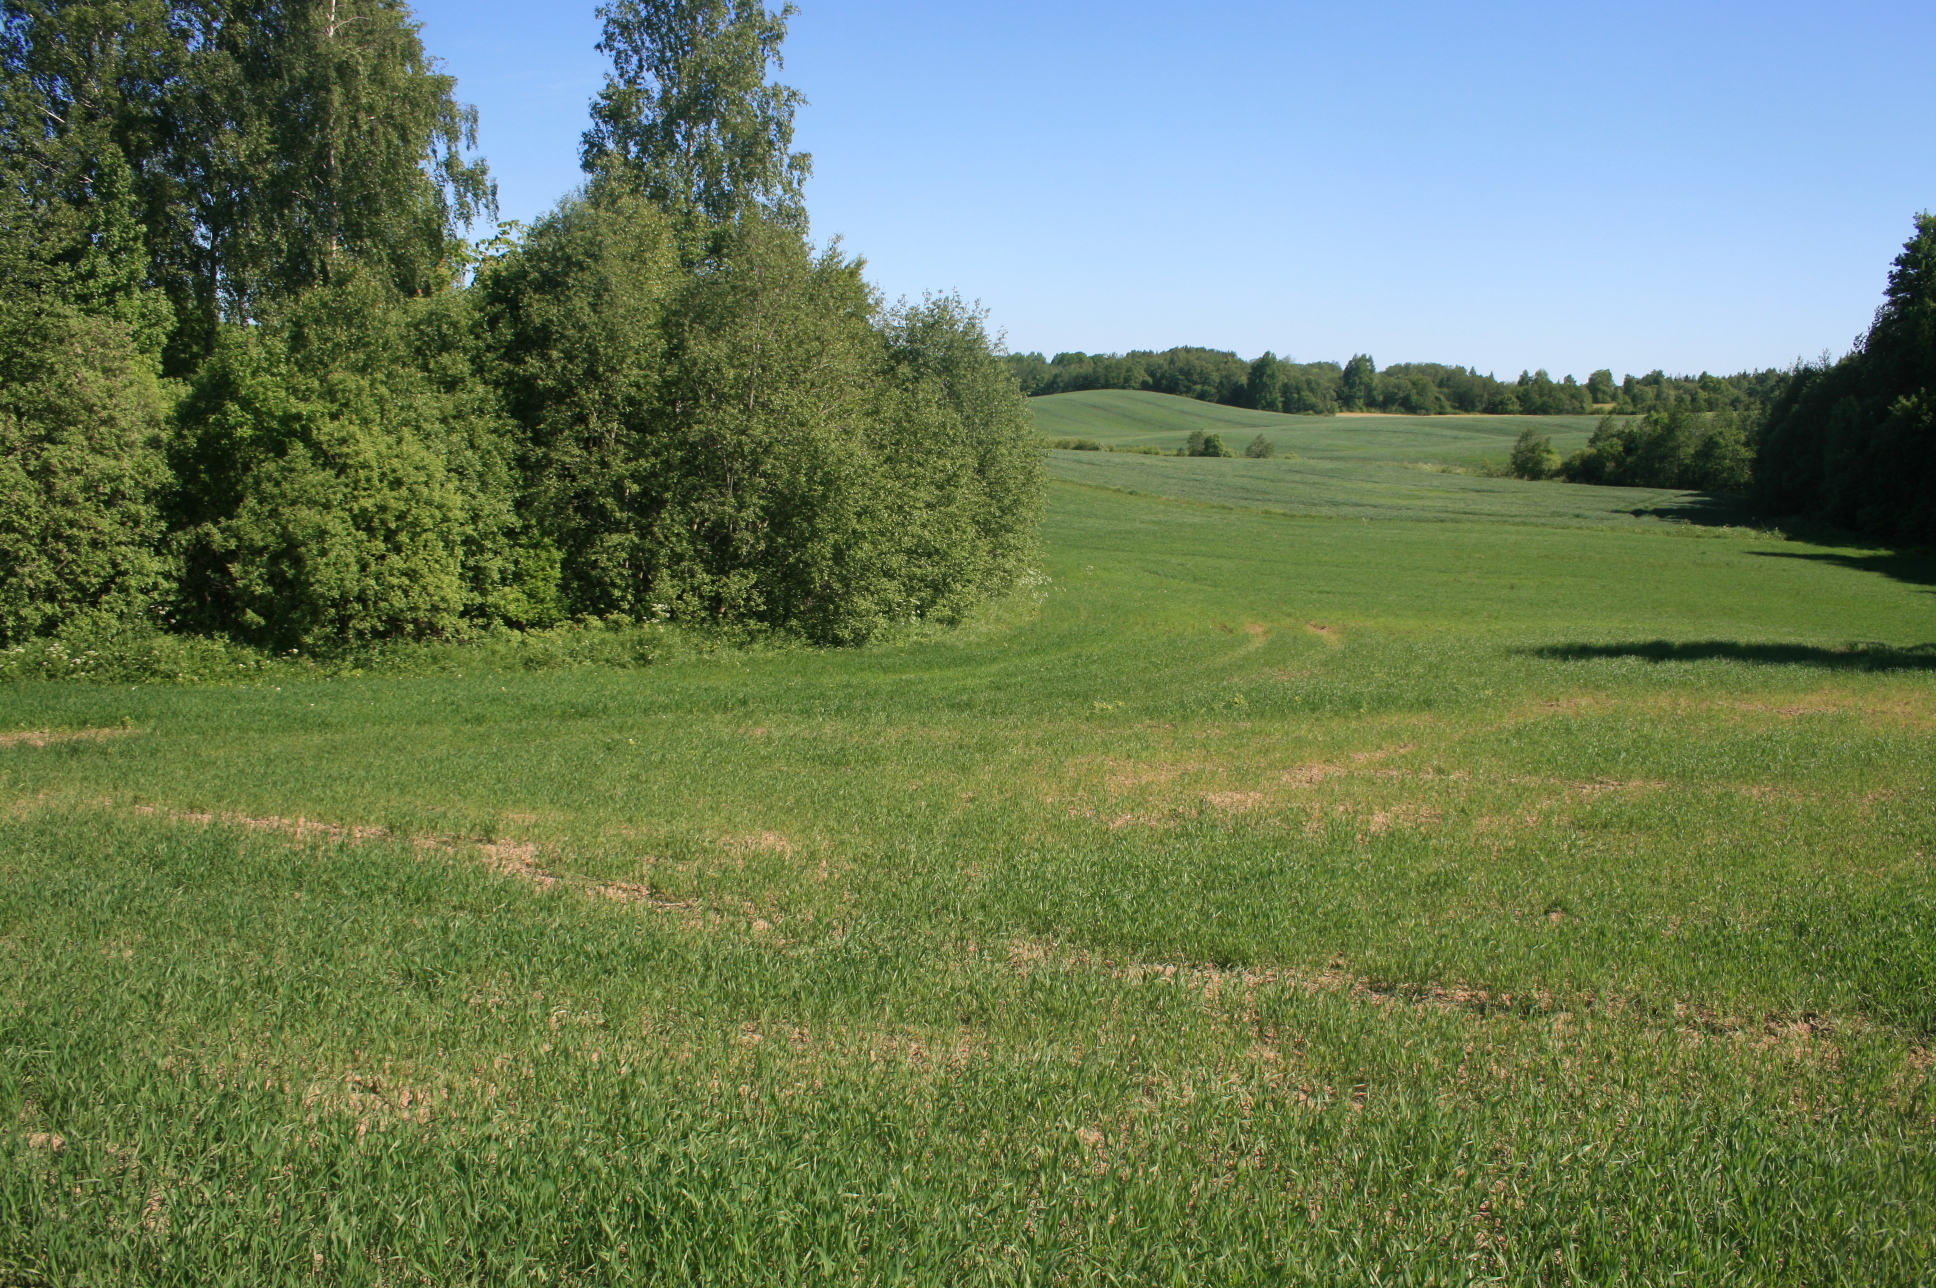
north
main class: Cropland
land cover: Common wheat
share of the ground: > 75 %
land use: Agriculture (excluding fallow land and kitchen gardens)
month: June
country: LT
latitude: 55.9066
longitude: 22.2608
